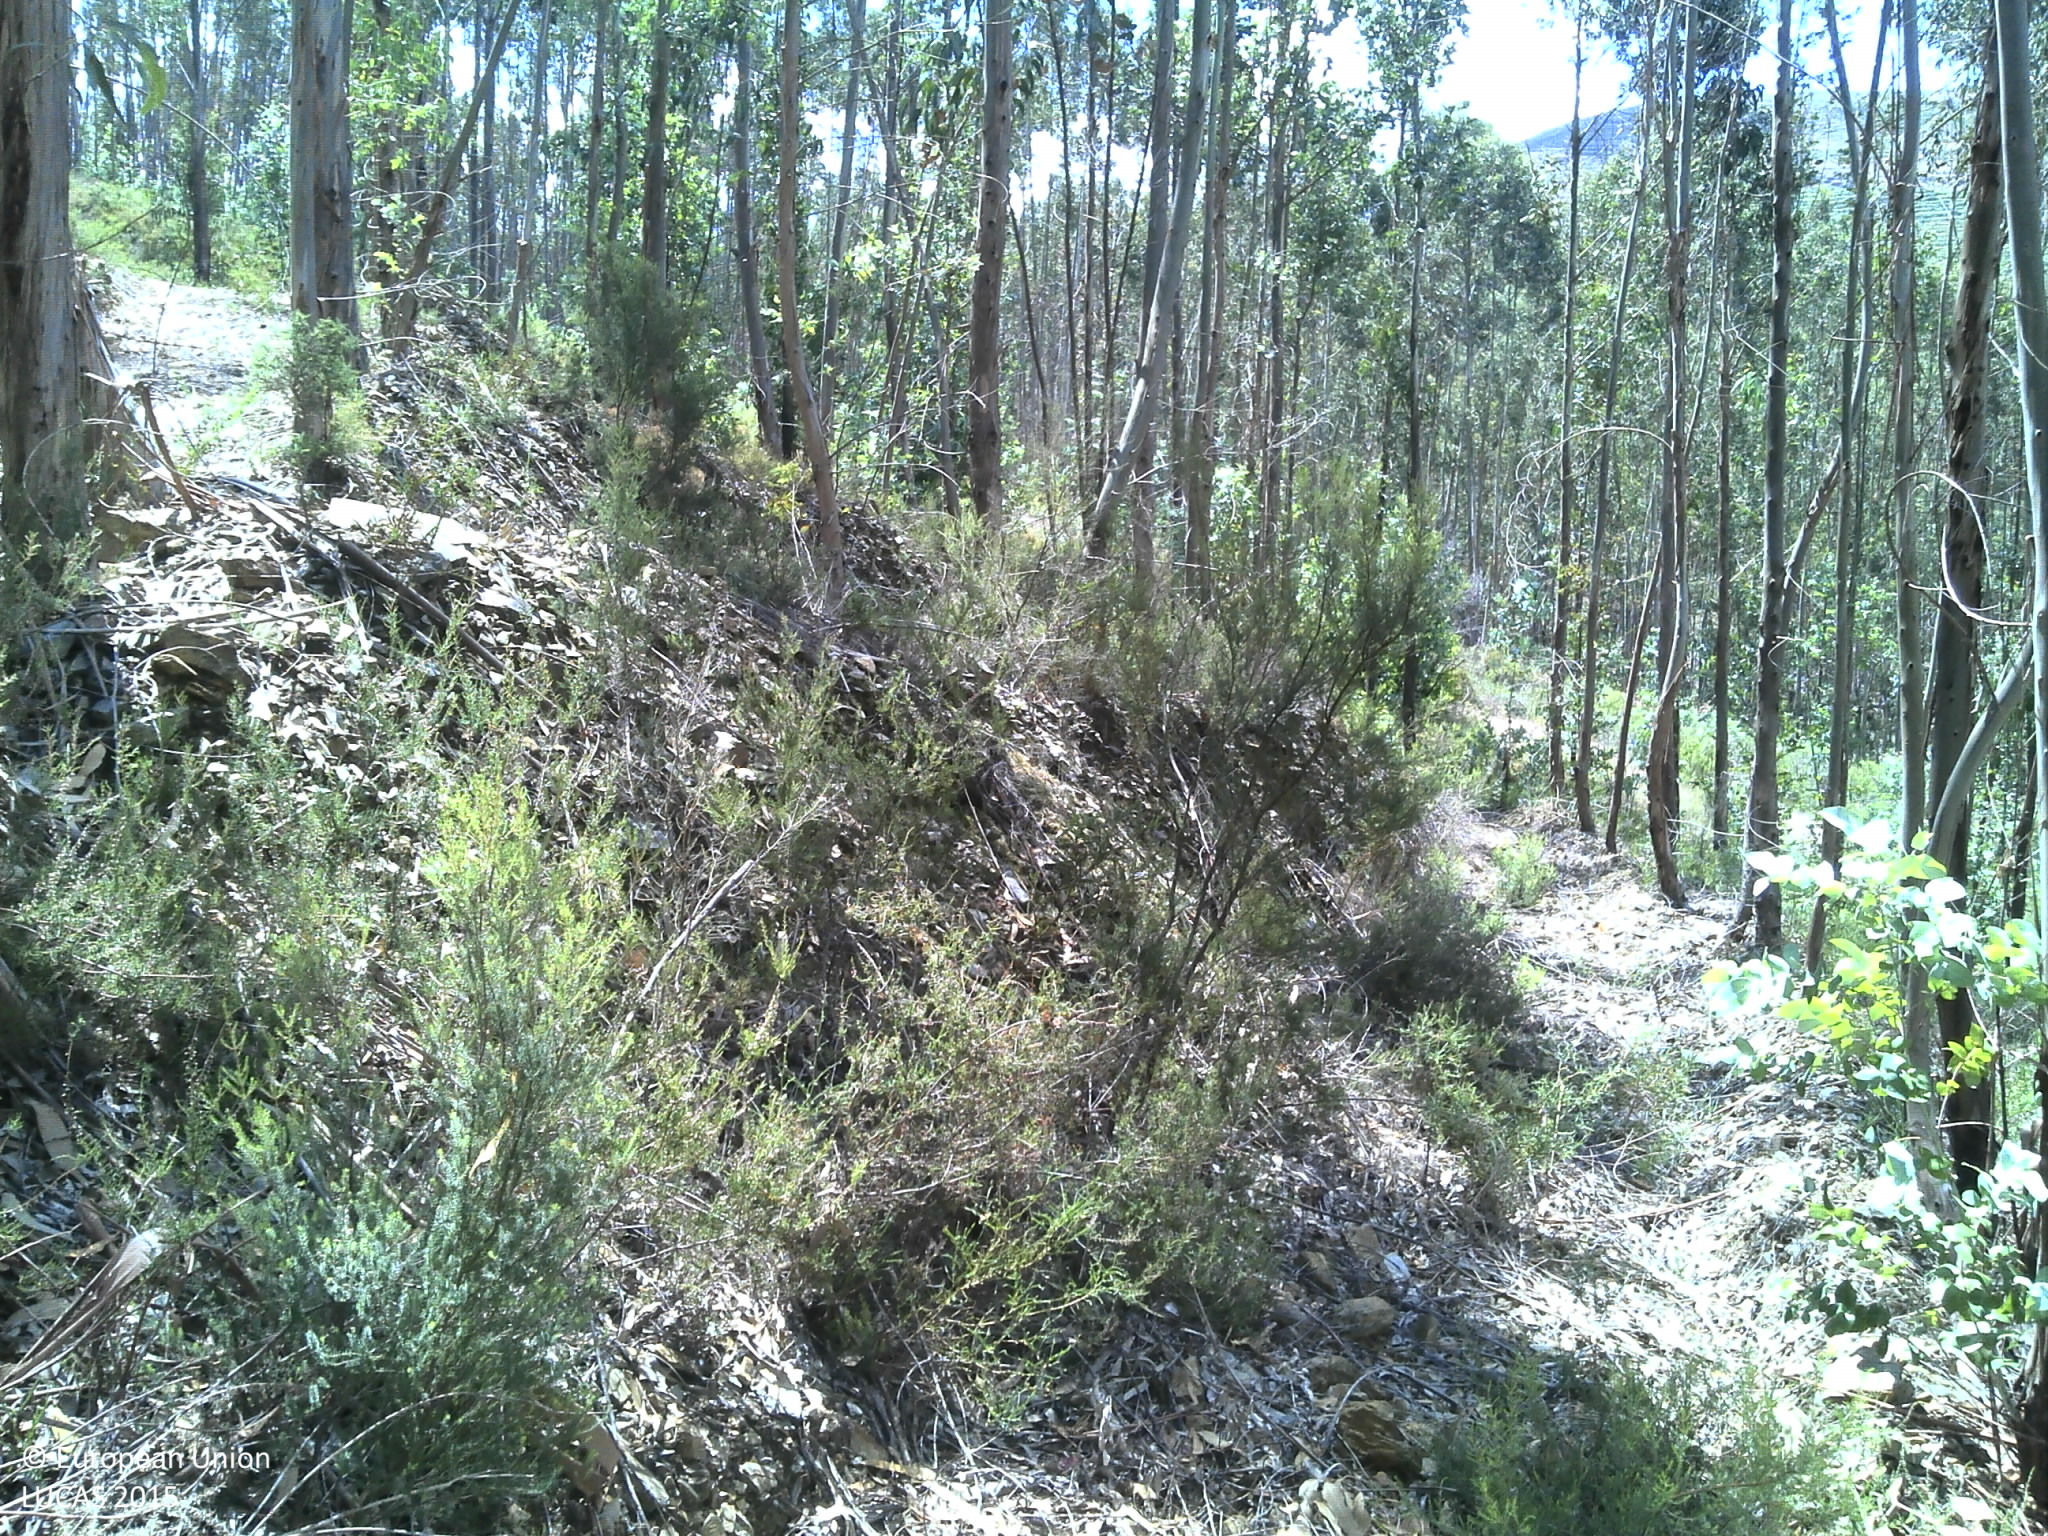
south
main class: Woodland
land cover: Broadleaved woodland
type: exotic forest
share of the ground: > 75 %
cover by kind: broadleaved forest trees 75 %, shrubs 15 %, unconsolidated bare surface 10 %
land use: Forestry
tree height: > 5 m
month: June
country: PT
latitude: 40.9194
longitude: -8.0749
